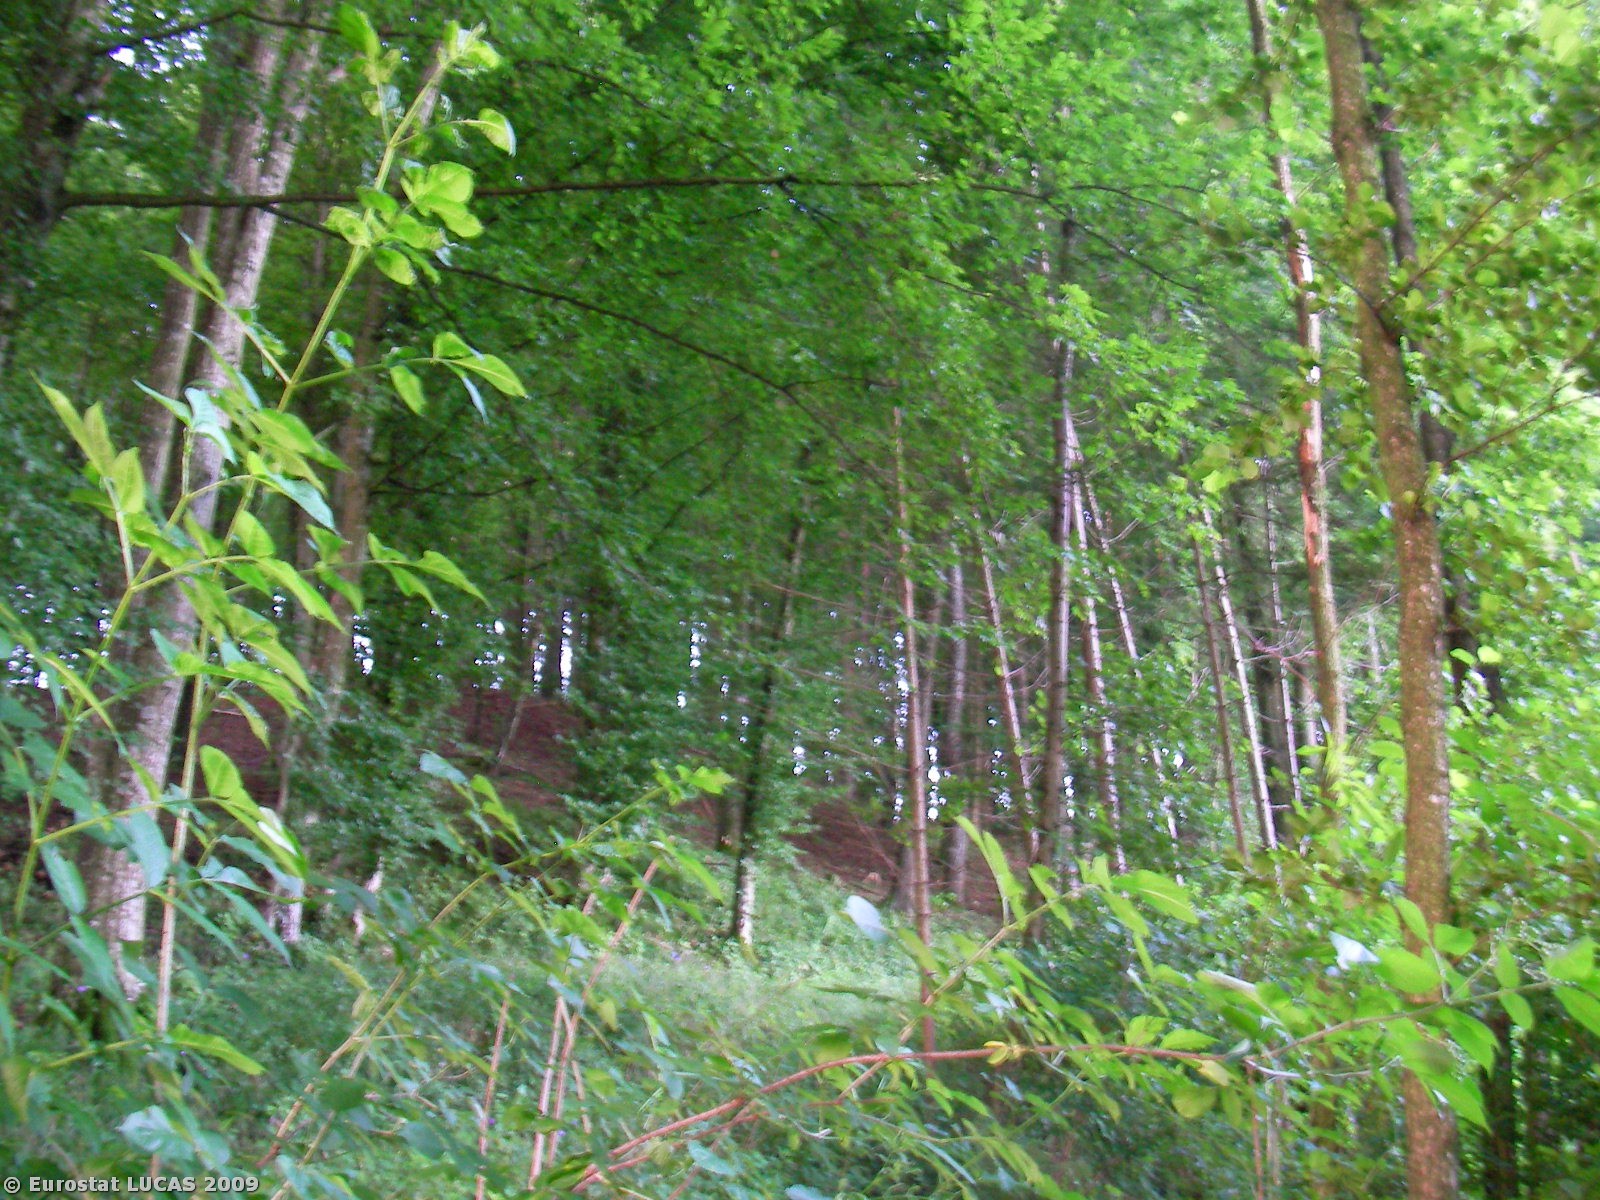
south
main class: Woodland
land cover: Broadleaved woodland
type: beech forest
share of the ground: > 75 %
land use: Forestry
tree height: > 5 m
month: July
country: AT
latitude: 46.9745
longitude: 15.7183
